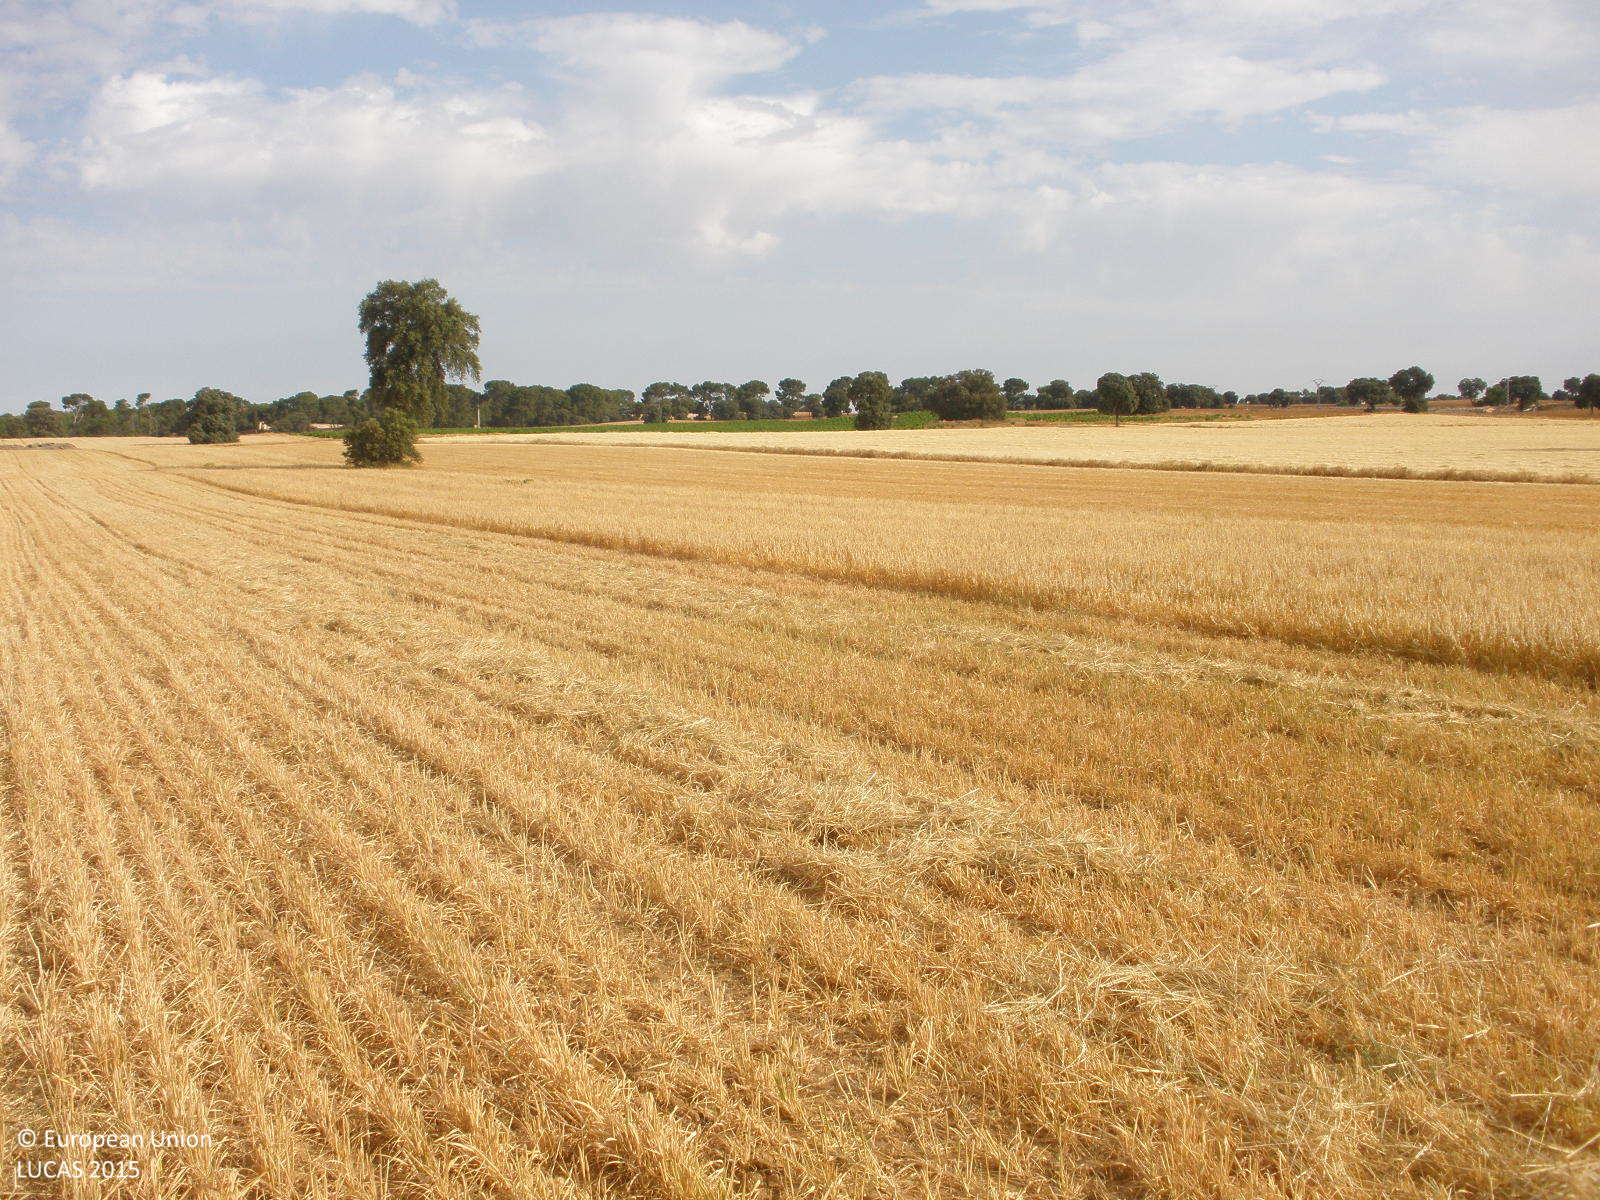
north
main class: Cropland
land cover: Oats
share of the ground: < 10 %
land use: Agriculture (excluding fallow land and kitchen gardens)
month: July
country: ES
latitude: 39.8059
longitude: -3.2341
